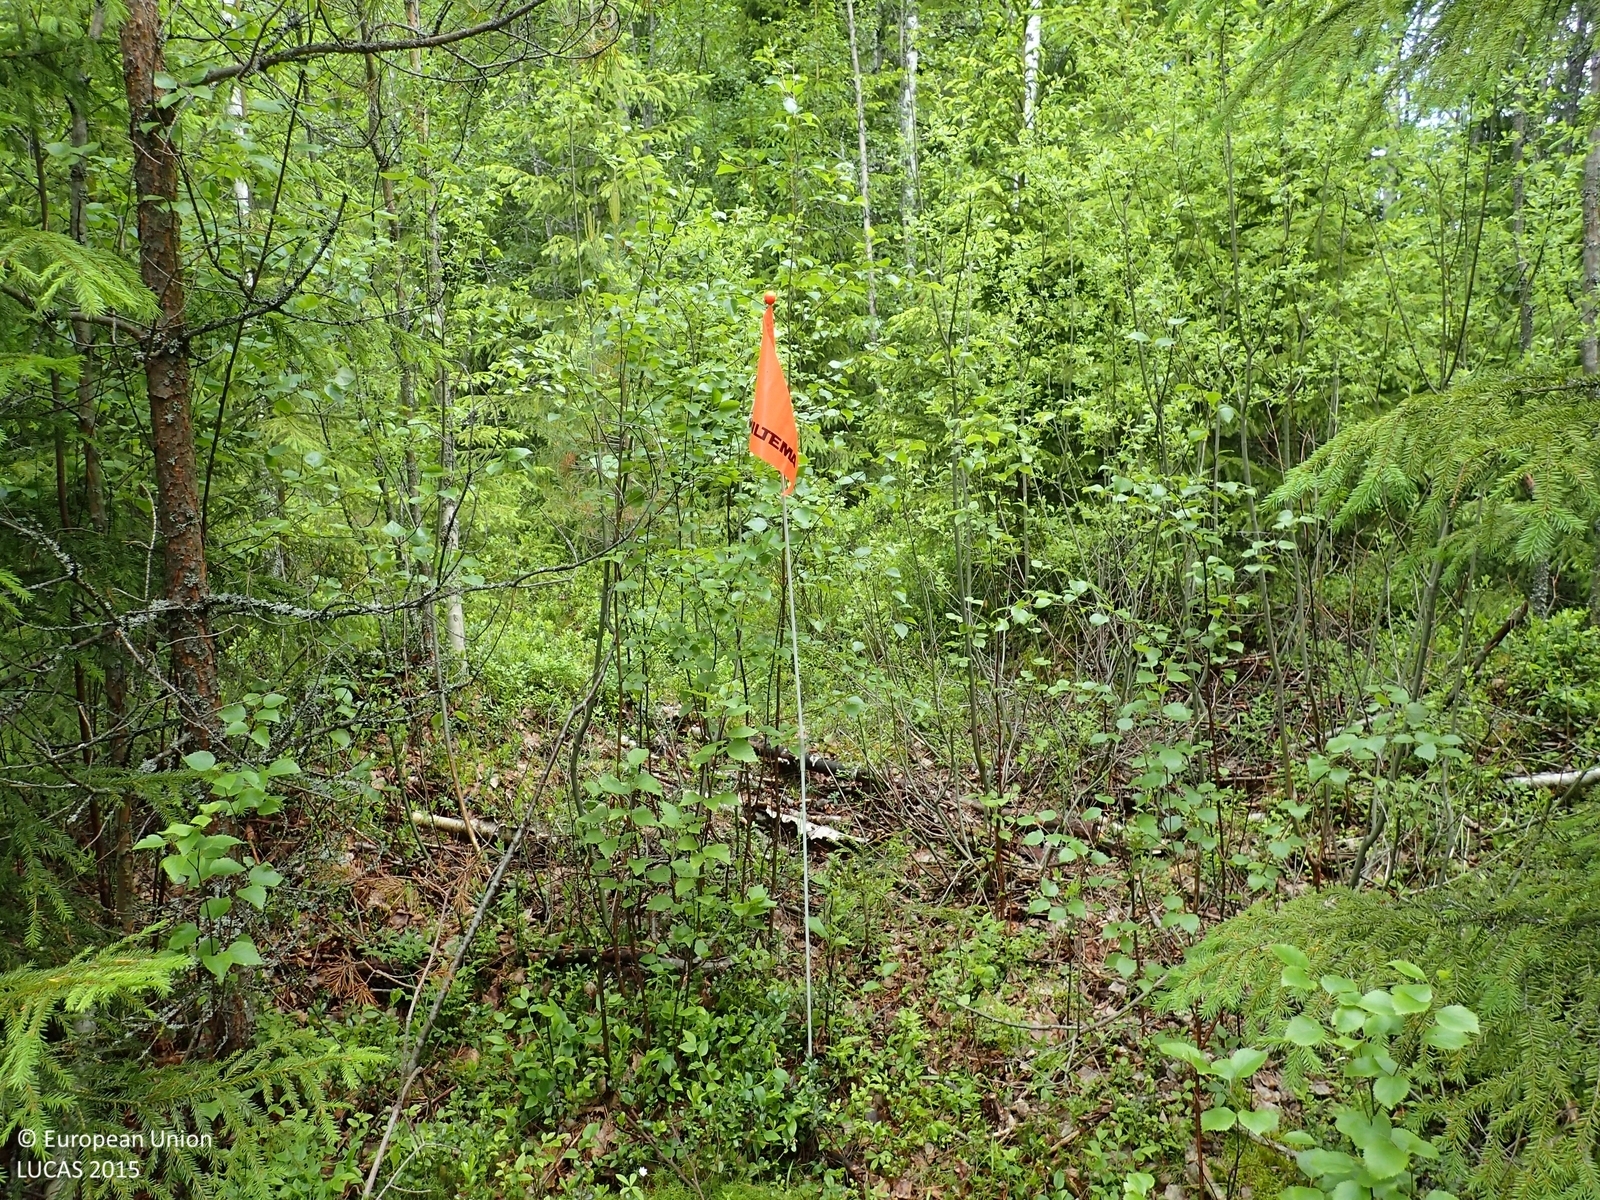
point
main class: Woodland
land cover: Other mixed woodland
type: boreal forest
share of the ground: > 75 %
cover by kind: broadleaved forest trees 45 %, coniferous forest trees 35 %, shrubs 20 %
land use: Forestry
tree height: > 5 m
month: June
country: FI
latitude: 62.3439
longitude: 21.3792
